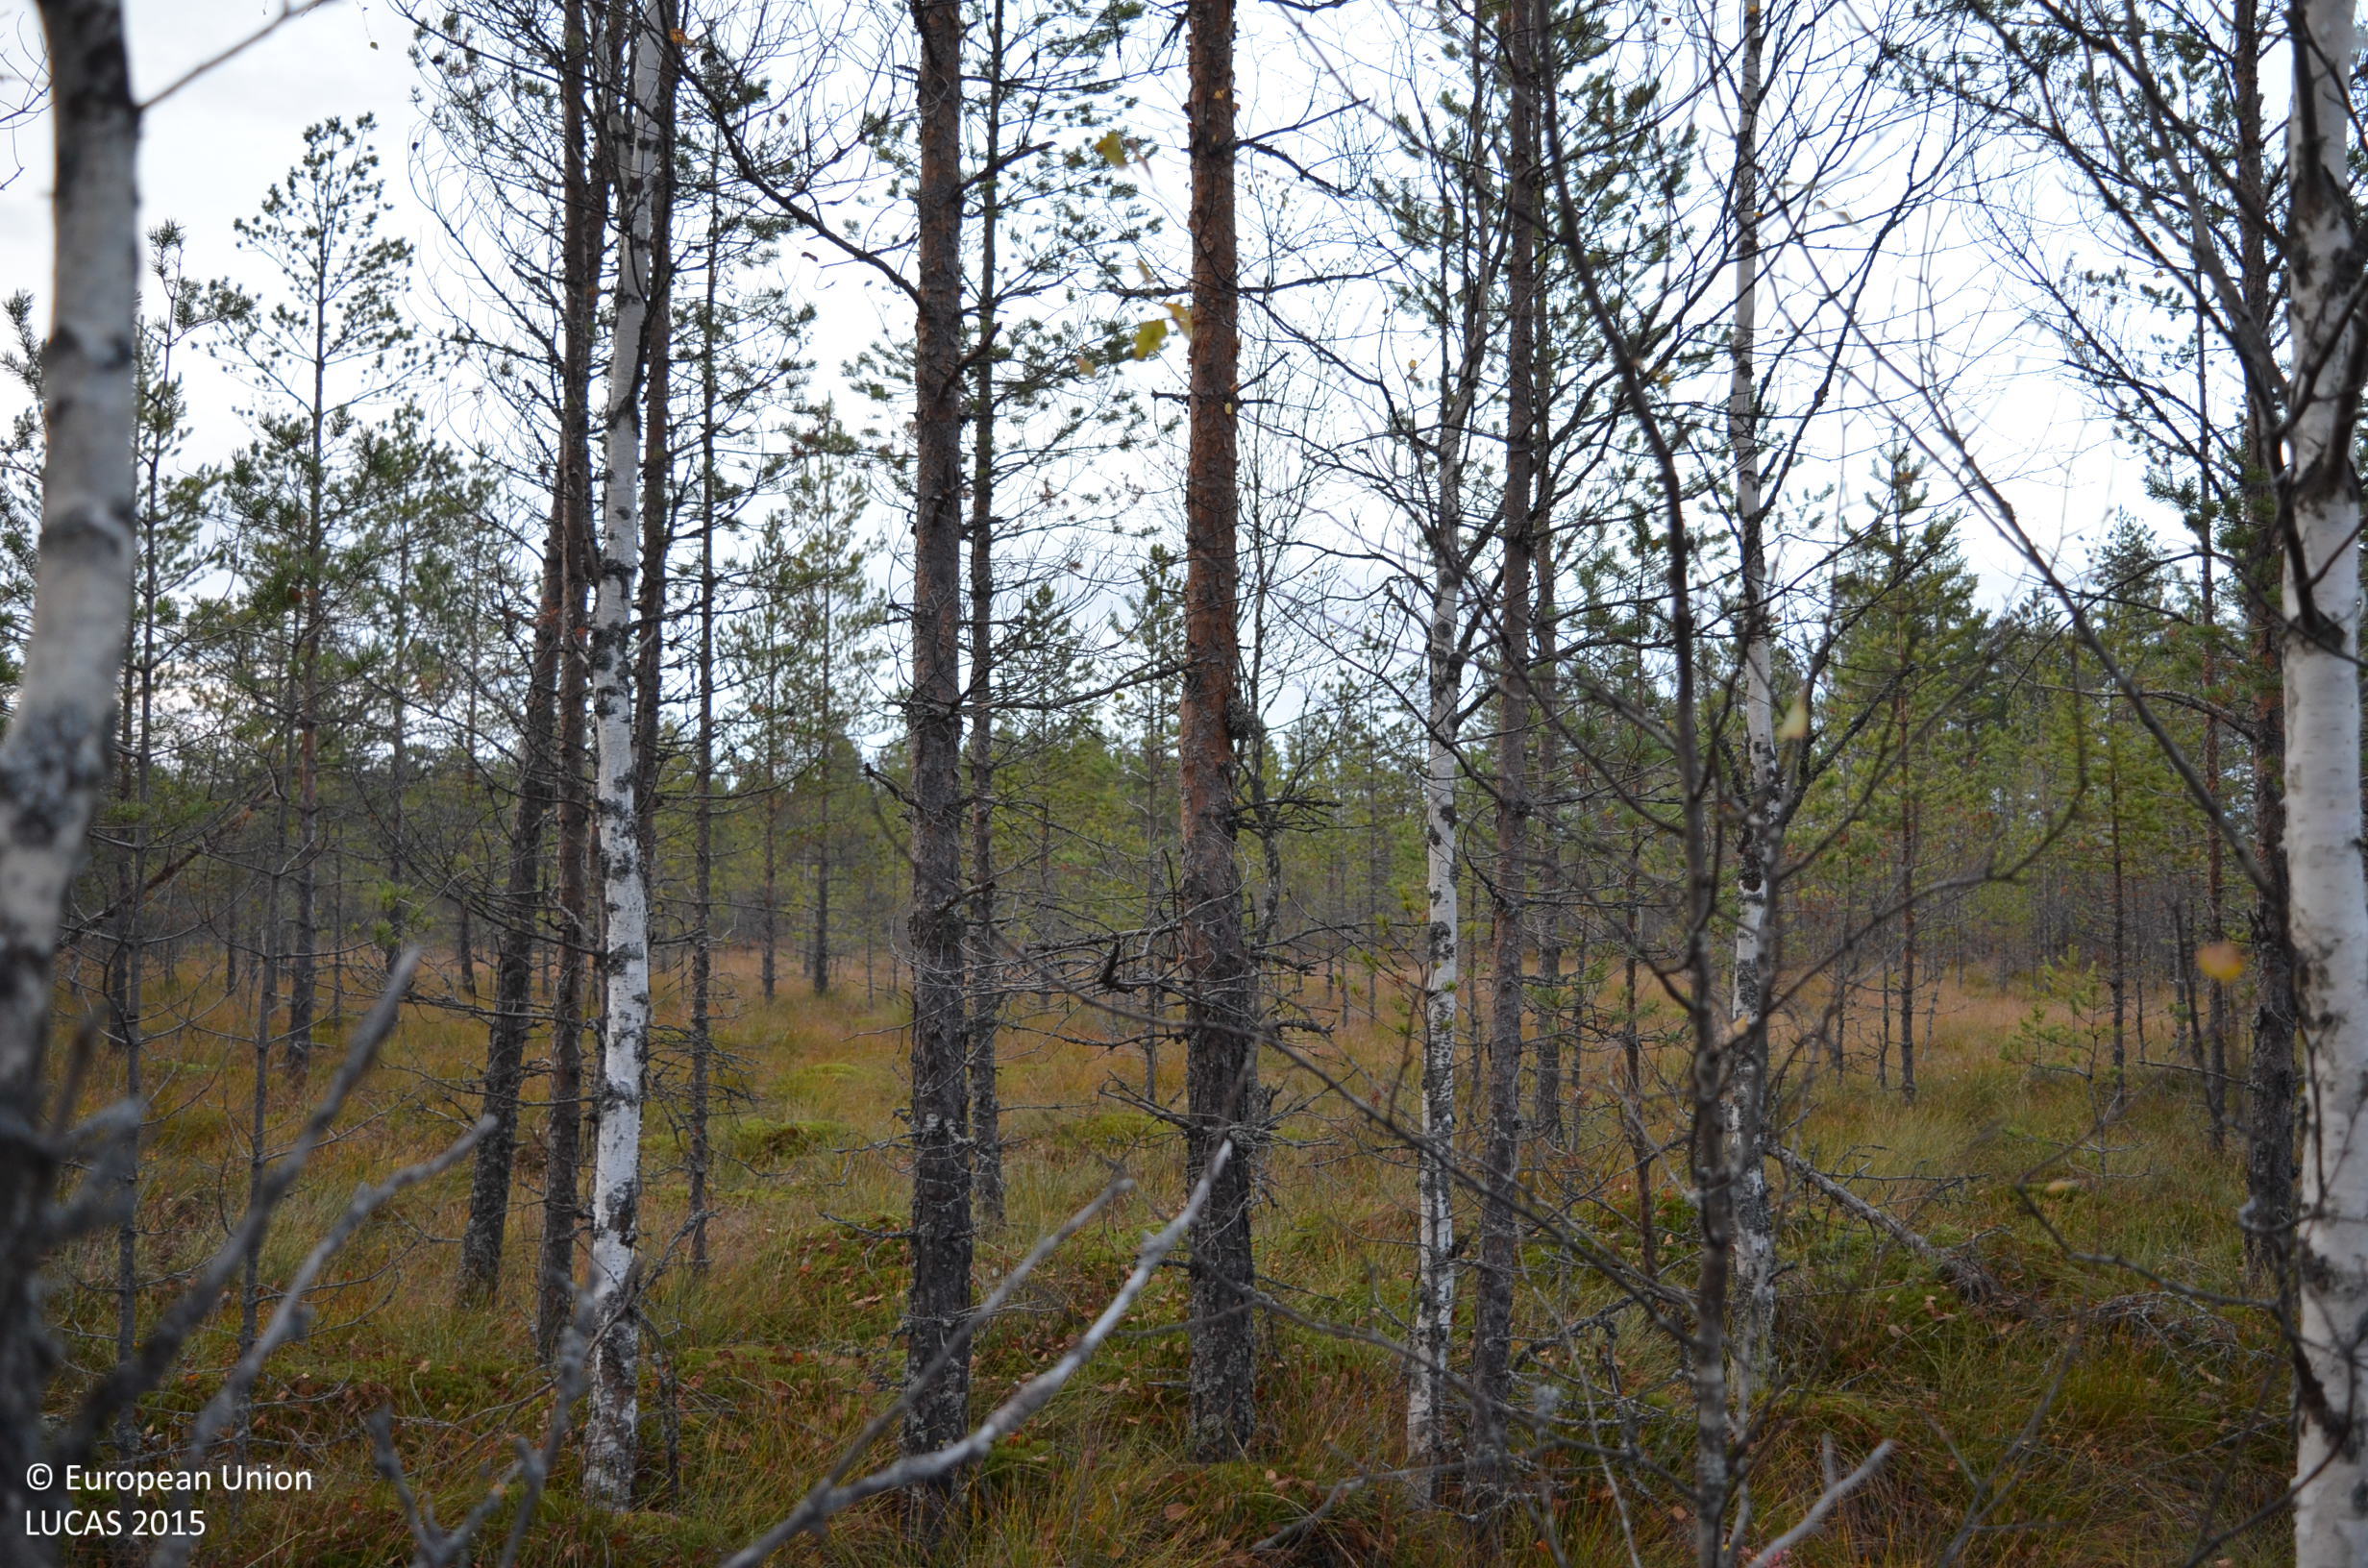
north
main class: Woodland
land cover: Pine dominated mixed woodland
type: mire and swamp forests
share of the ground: 25 - 50 %
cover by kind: coniferous forest trees 30 %, herbaceous plants 20 %, lichens and mosses 20 %, broadleaved forest trees 15 %, shrubs 15 %
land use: Semi-natural and natural areas not in use
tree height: < 5 m
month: October
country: FI
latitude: 62.3319
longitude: 23.4887
